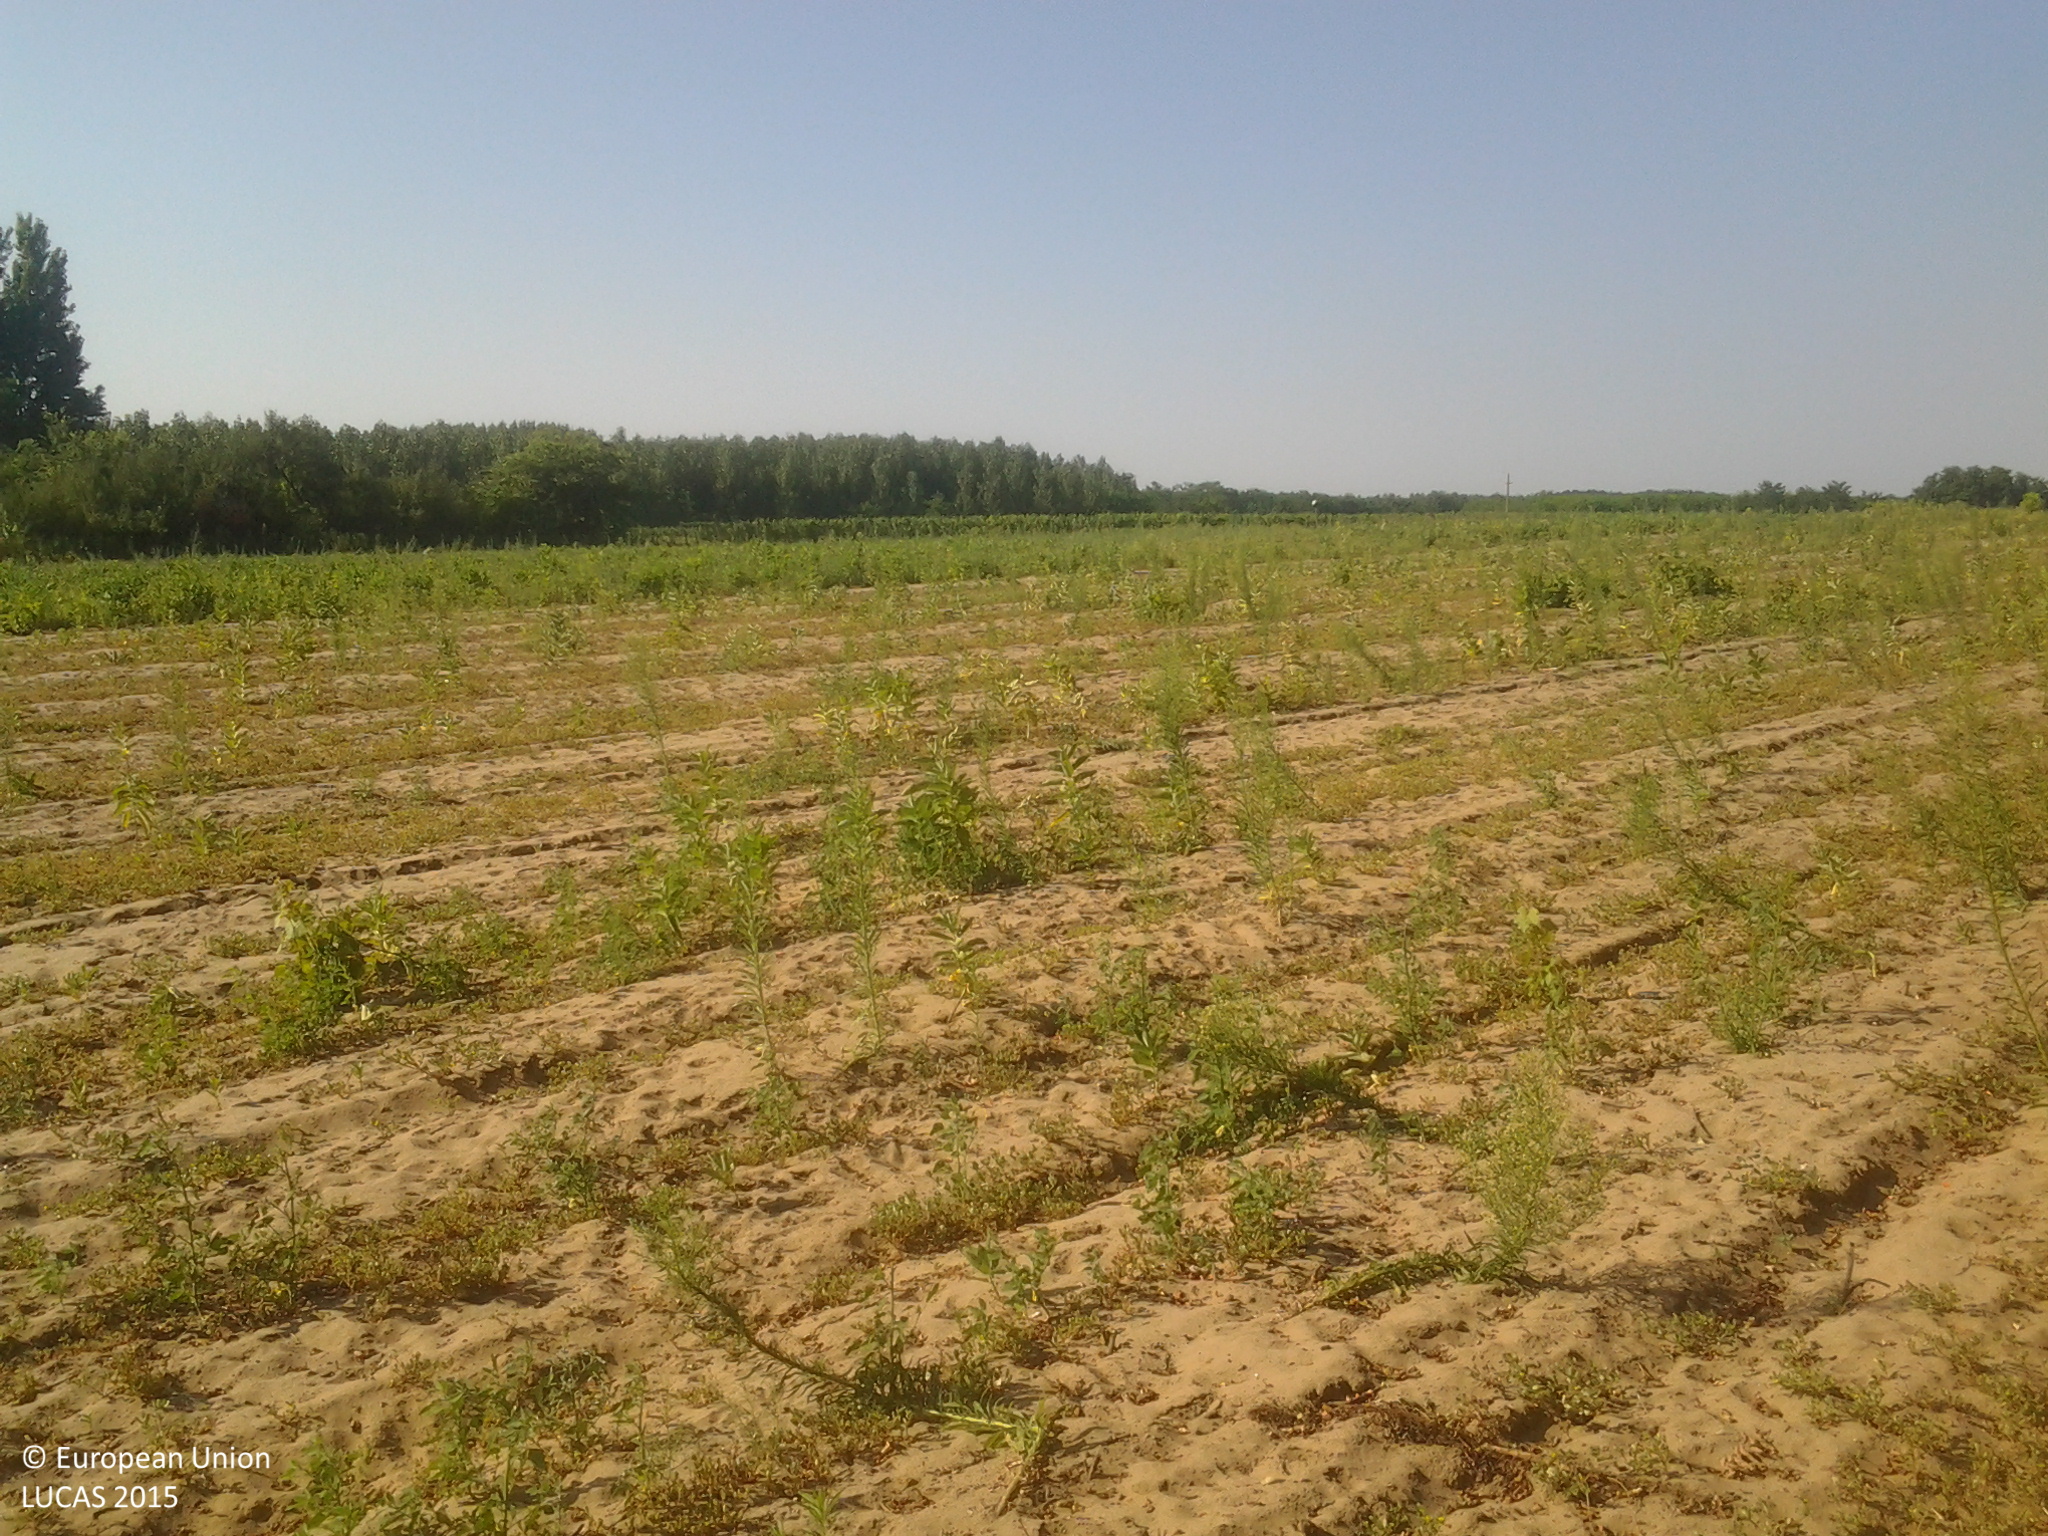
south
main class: Grassland
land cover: Spontaneously vegetated surfaces
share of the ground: 50 - 75 %
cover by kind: herbaceous plants 65 %, unconsolidated bare surface 35 %
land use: Forestry
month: July
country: HU
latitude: 46.5132
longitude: 19.2300
